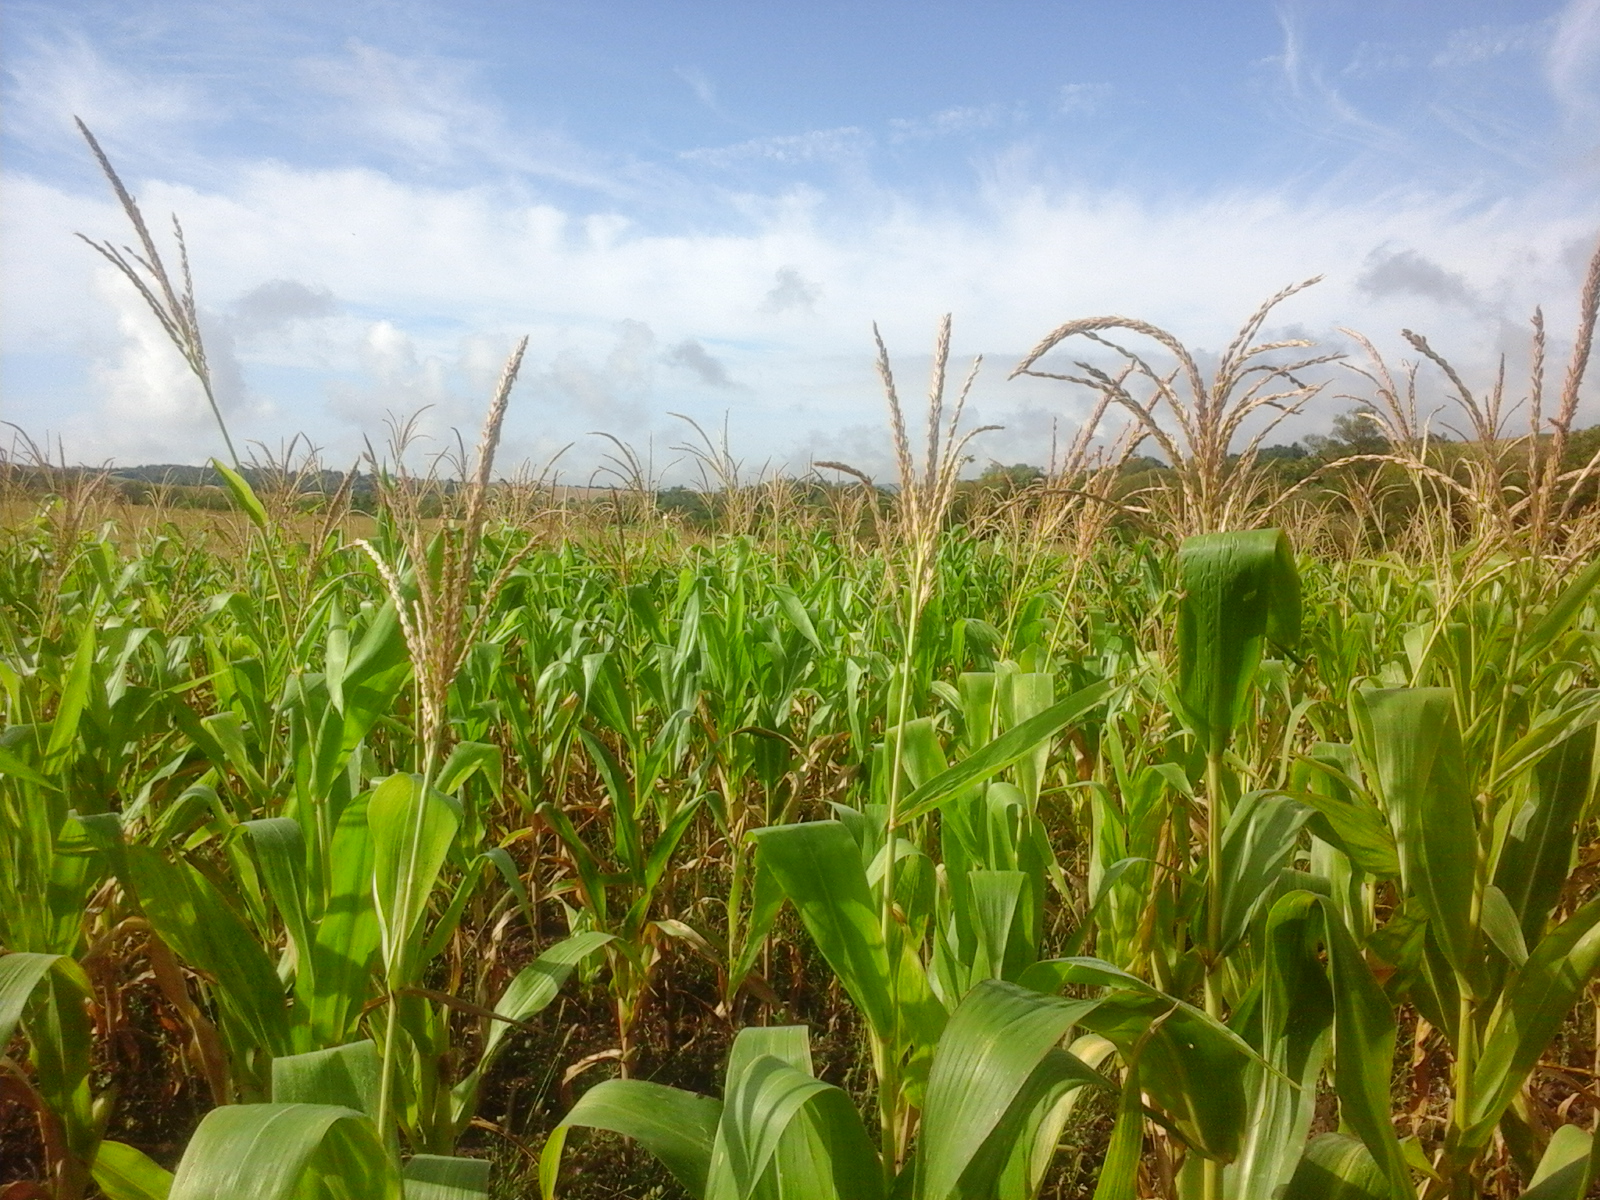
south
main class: Cropland
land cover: Maize
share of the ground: > 75 %
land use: Agriculture (excluding fallow land and kitchen gardens)
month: August
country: RO
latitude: 45.1872
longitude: 21.6265
